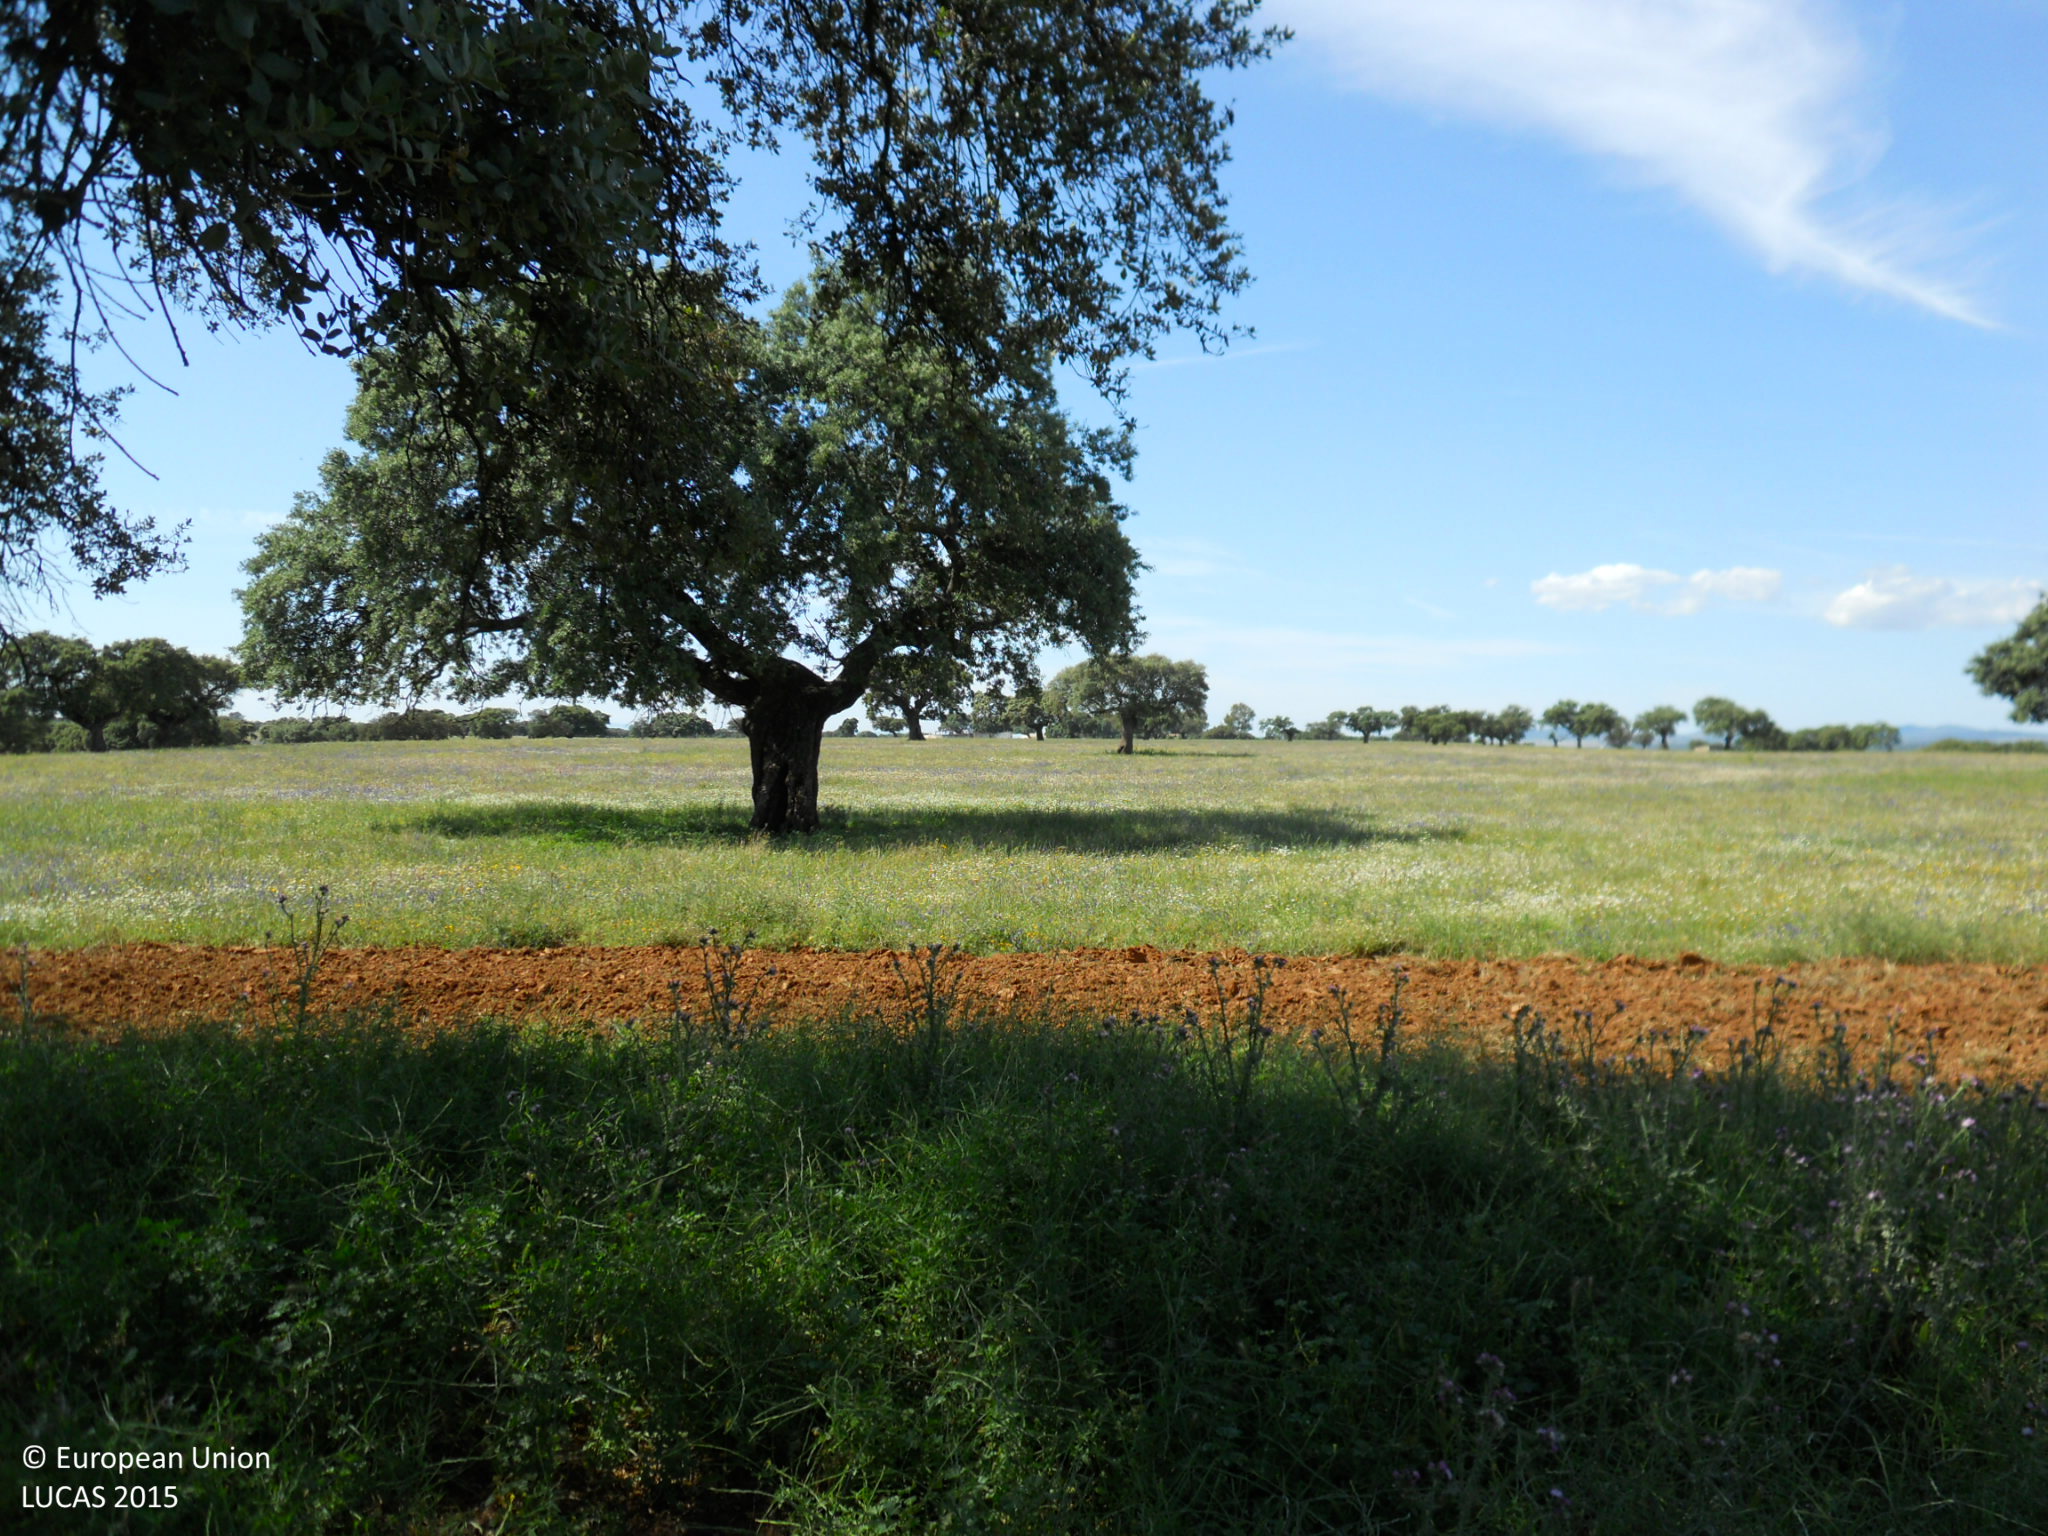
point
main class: Grassland
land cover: Grassland without tree/shrub cover
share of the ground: > 75 %
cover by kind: herbaceous plants 100 %
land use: Agriculture (excluding fallow land and kitchen gardens)
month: April
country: ES
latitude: 39.0031
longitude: -6.9419
